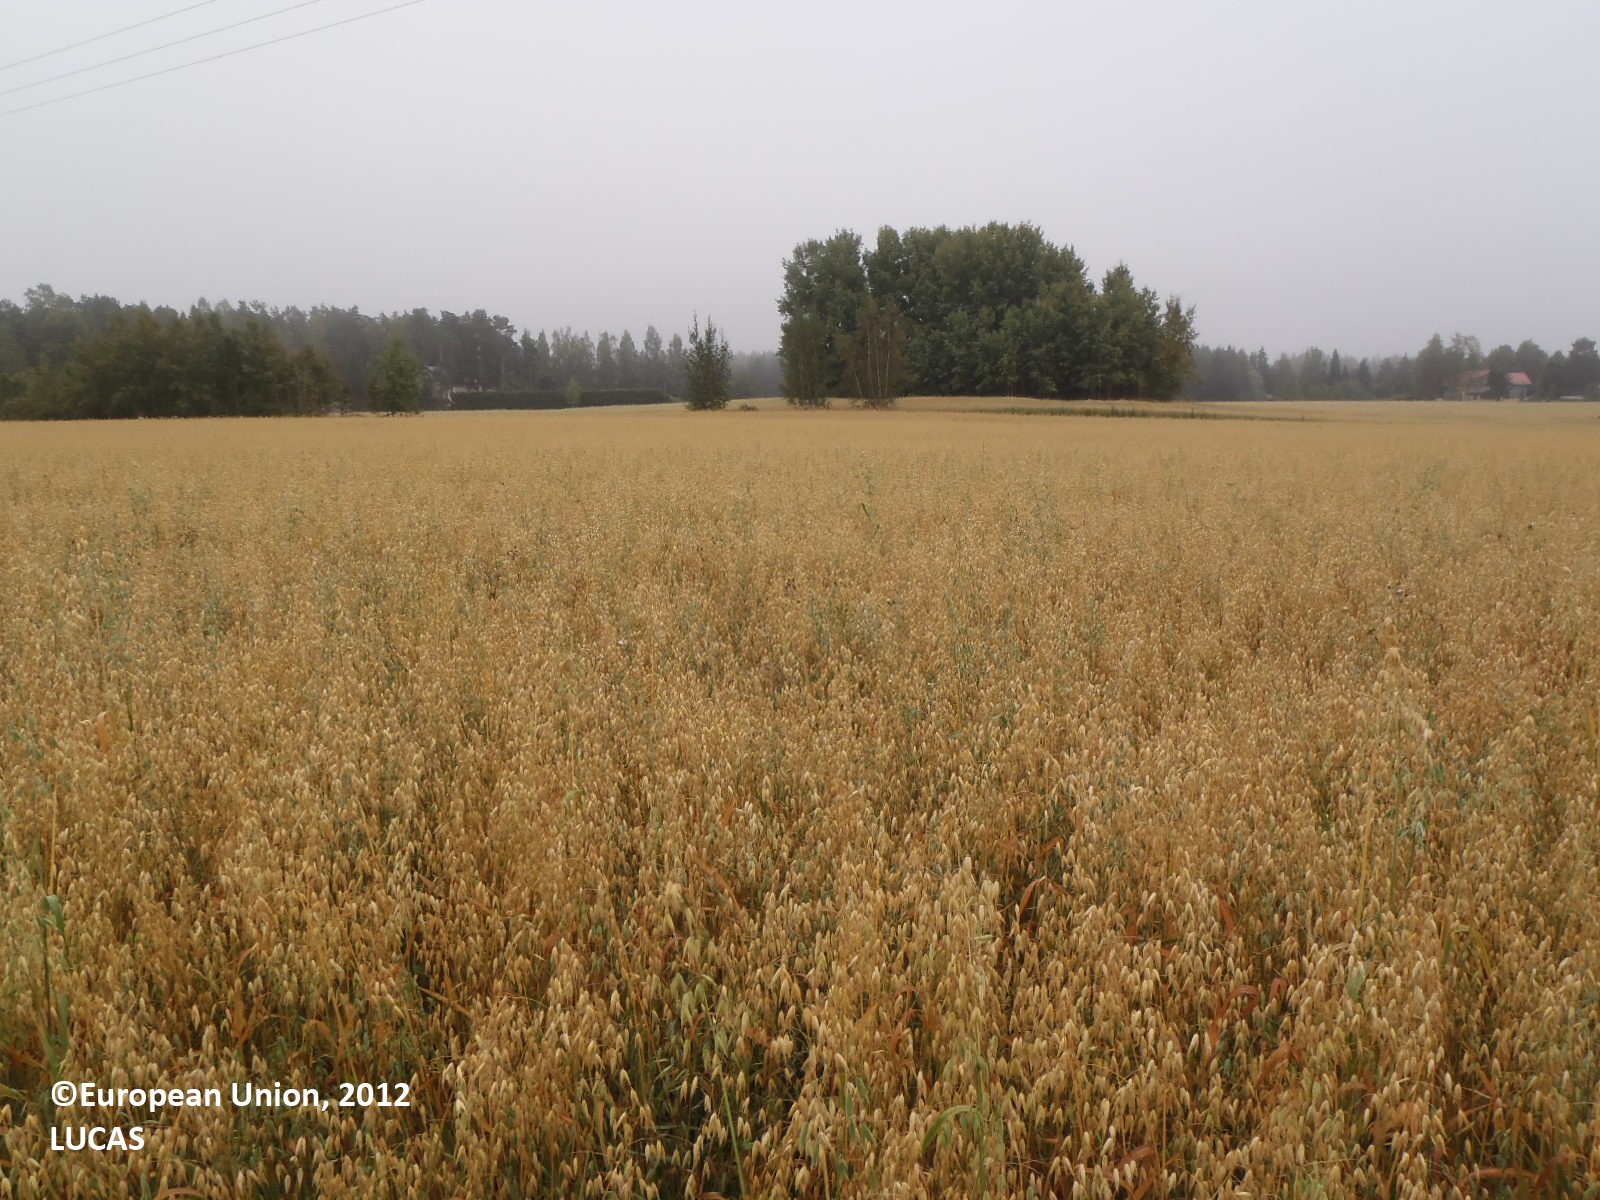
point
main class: Cropland
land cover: Oats
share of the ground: > 75 %
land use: Agriculture (excluding fallow land and kitchen gardens)
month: August
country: FI
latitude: 60.6540
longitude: 22.6010
